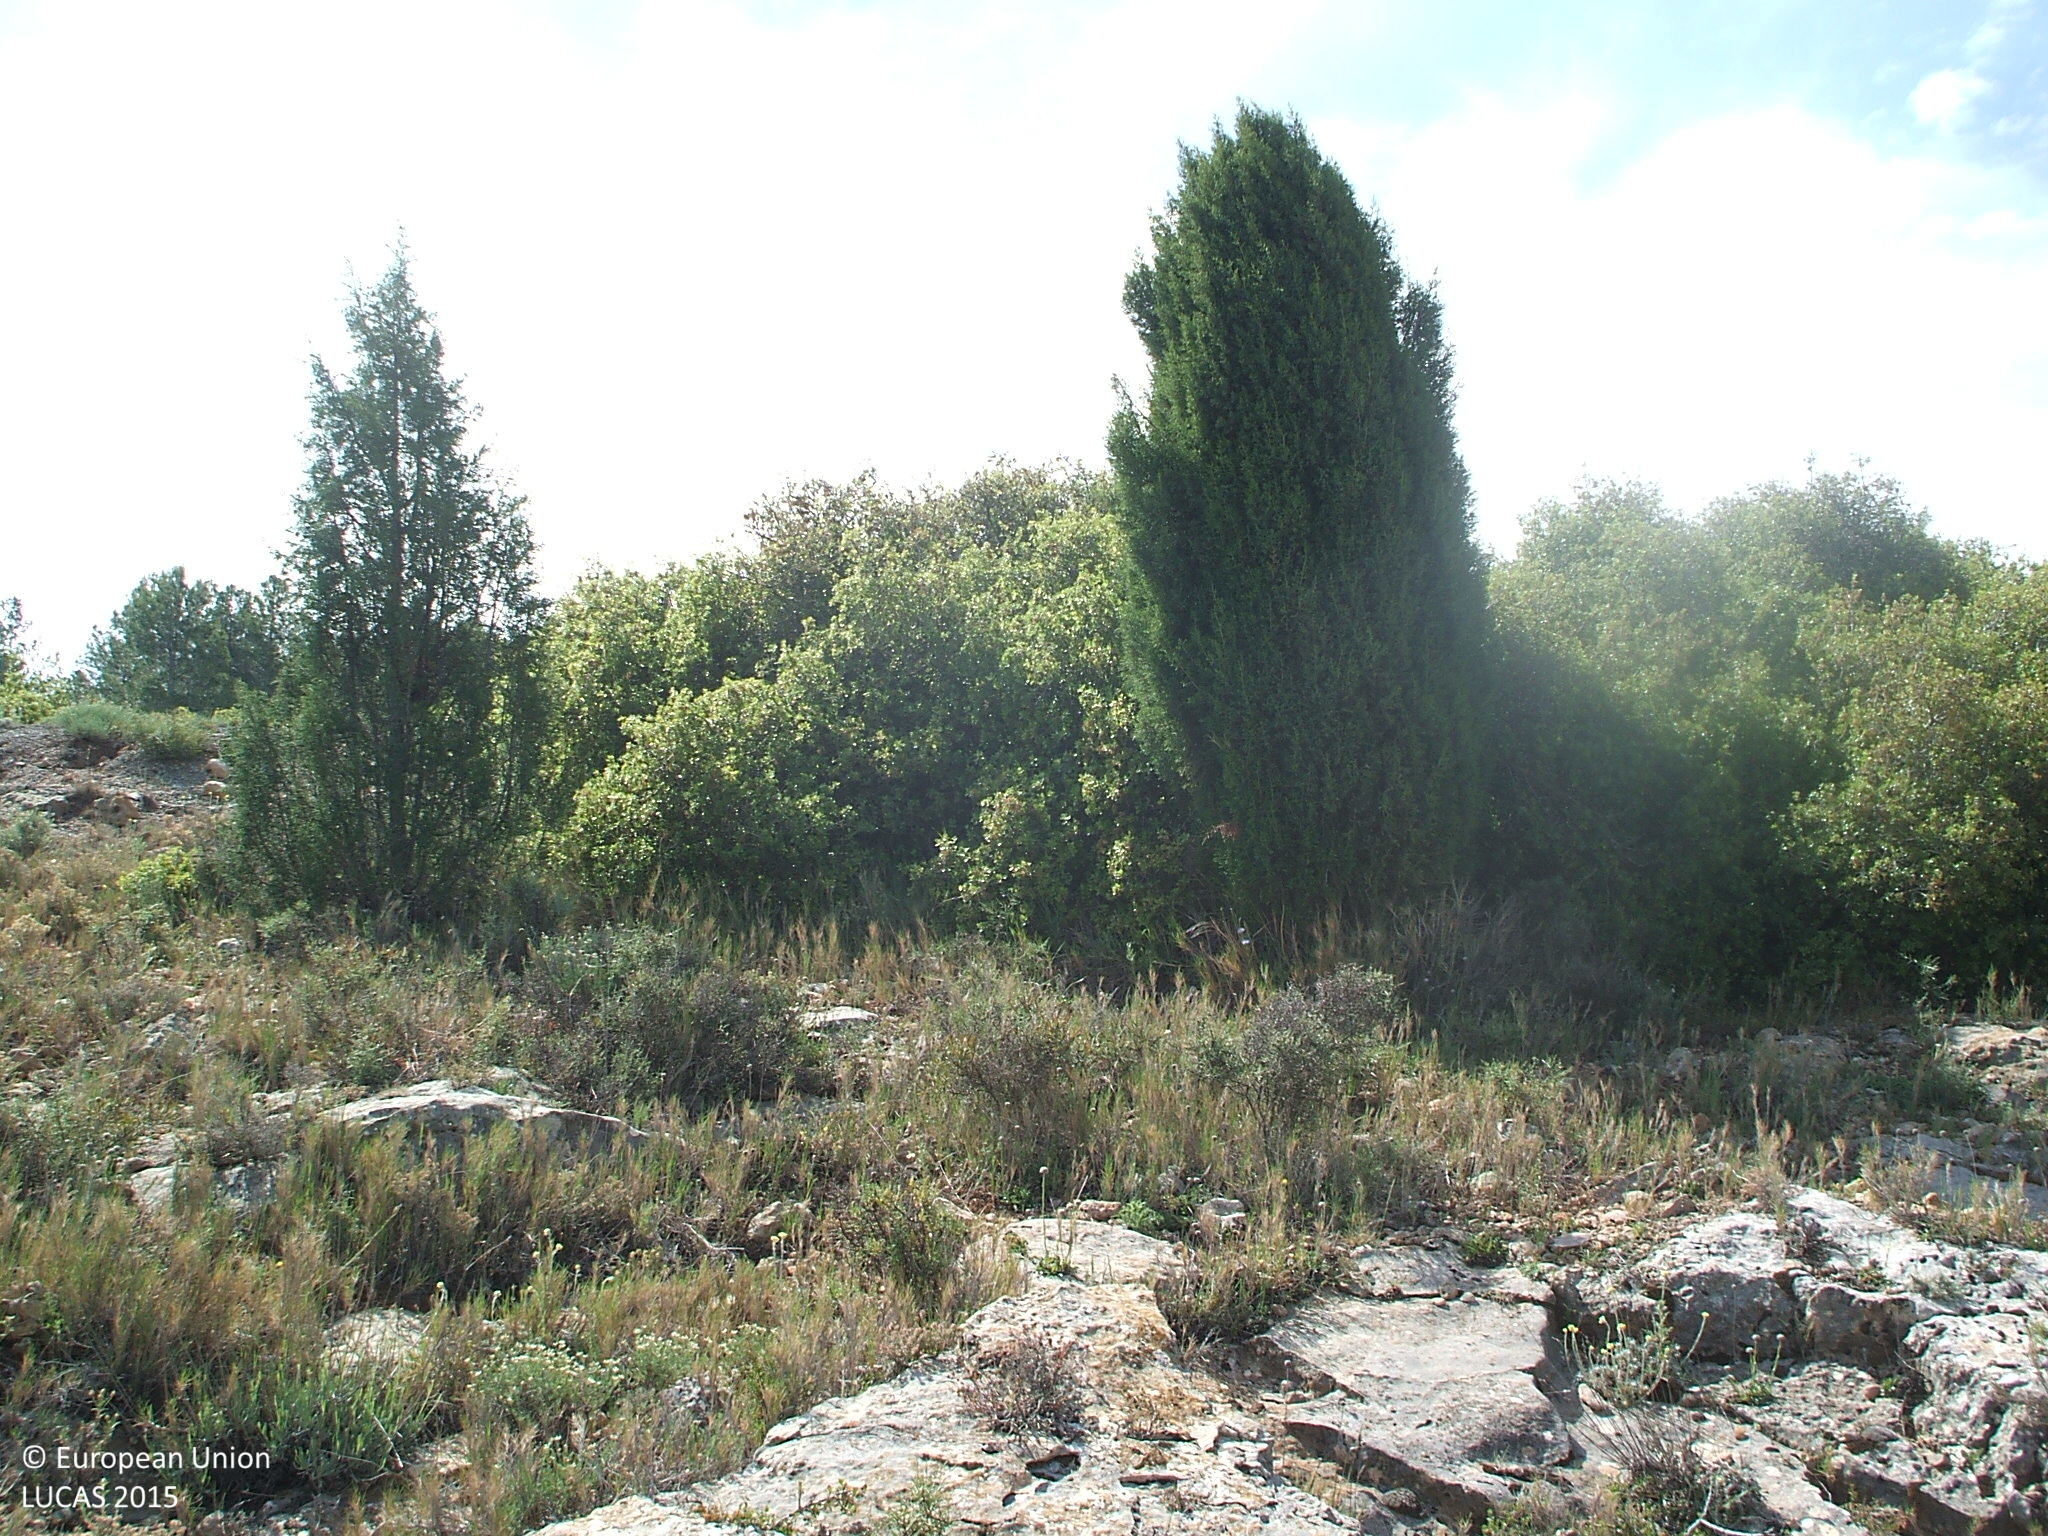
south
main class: Shrubland
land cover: Shrubland with sparse tree cover
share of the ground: > 75 %
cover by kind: shrubs 90 %, coniferous forest trees 5 %, herbaceous plants 5 %
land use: Semi-natural and natural areas not in use
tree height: > 5 m
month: May
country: ES
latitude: 40.1187
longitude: -0.6950
